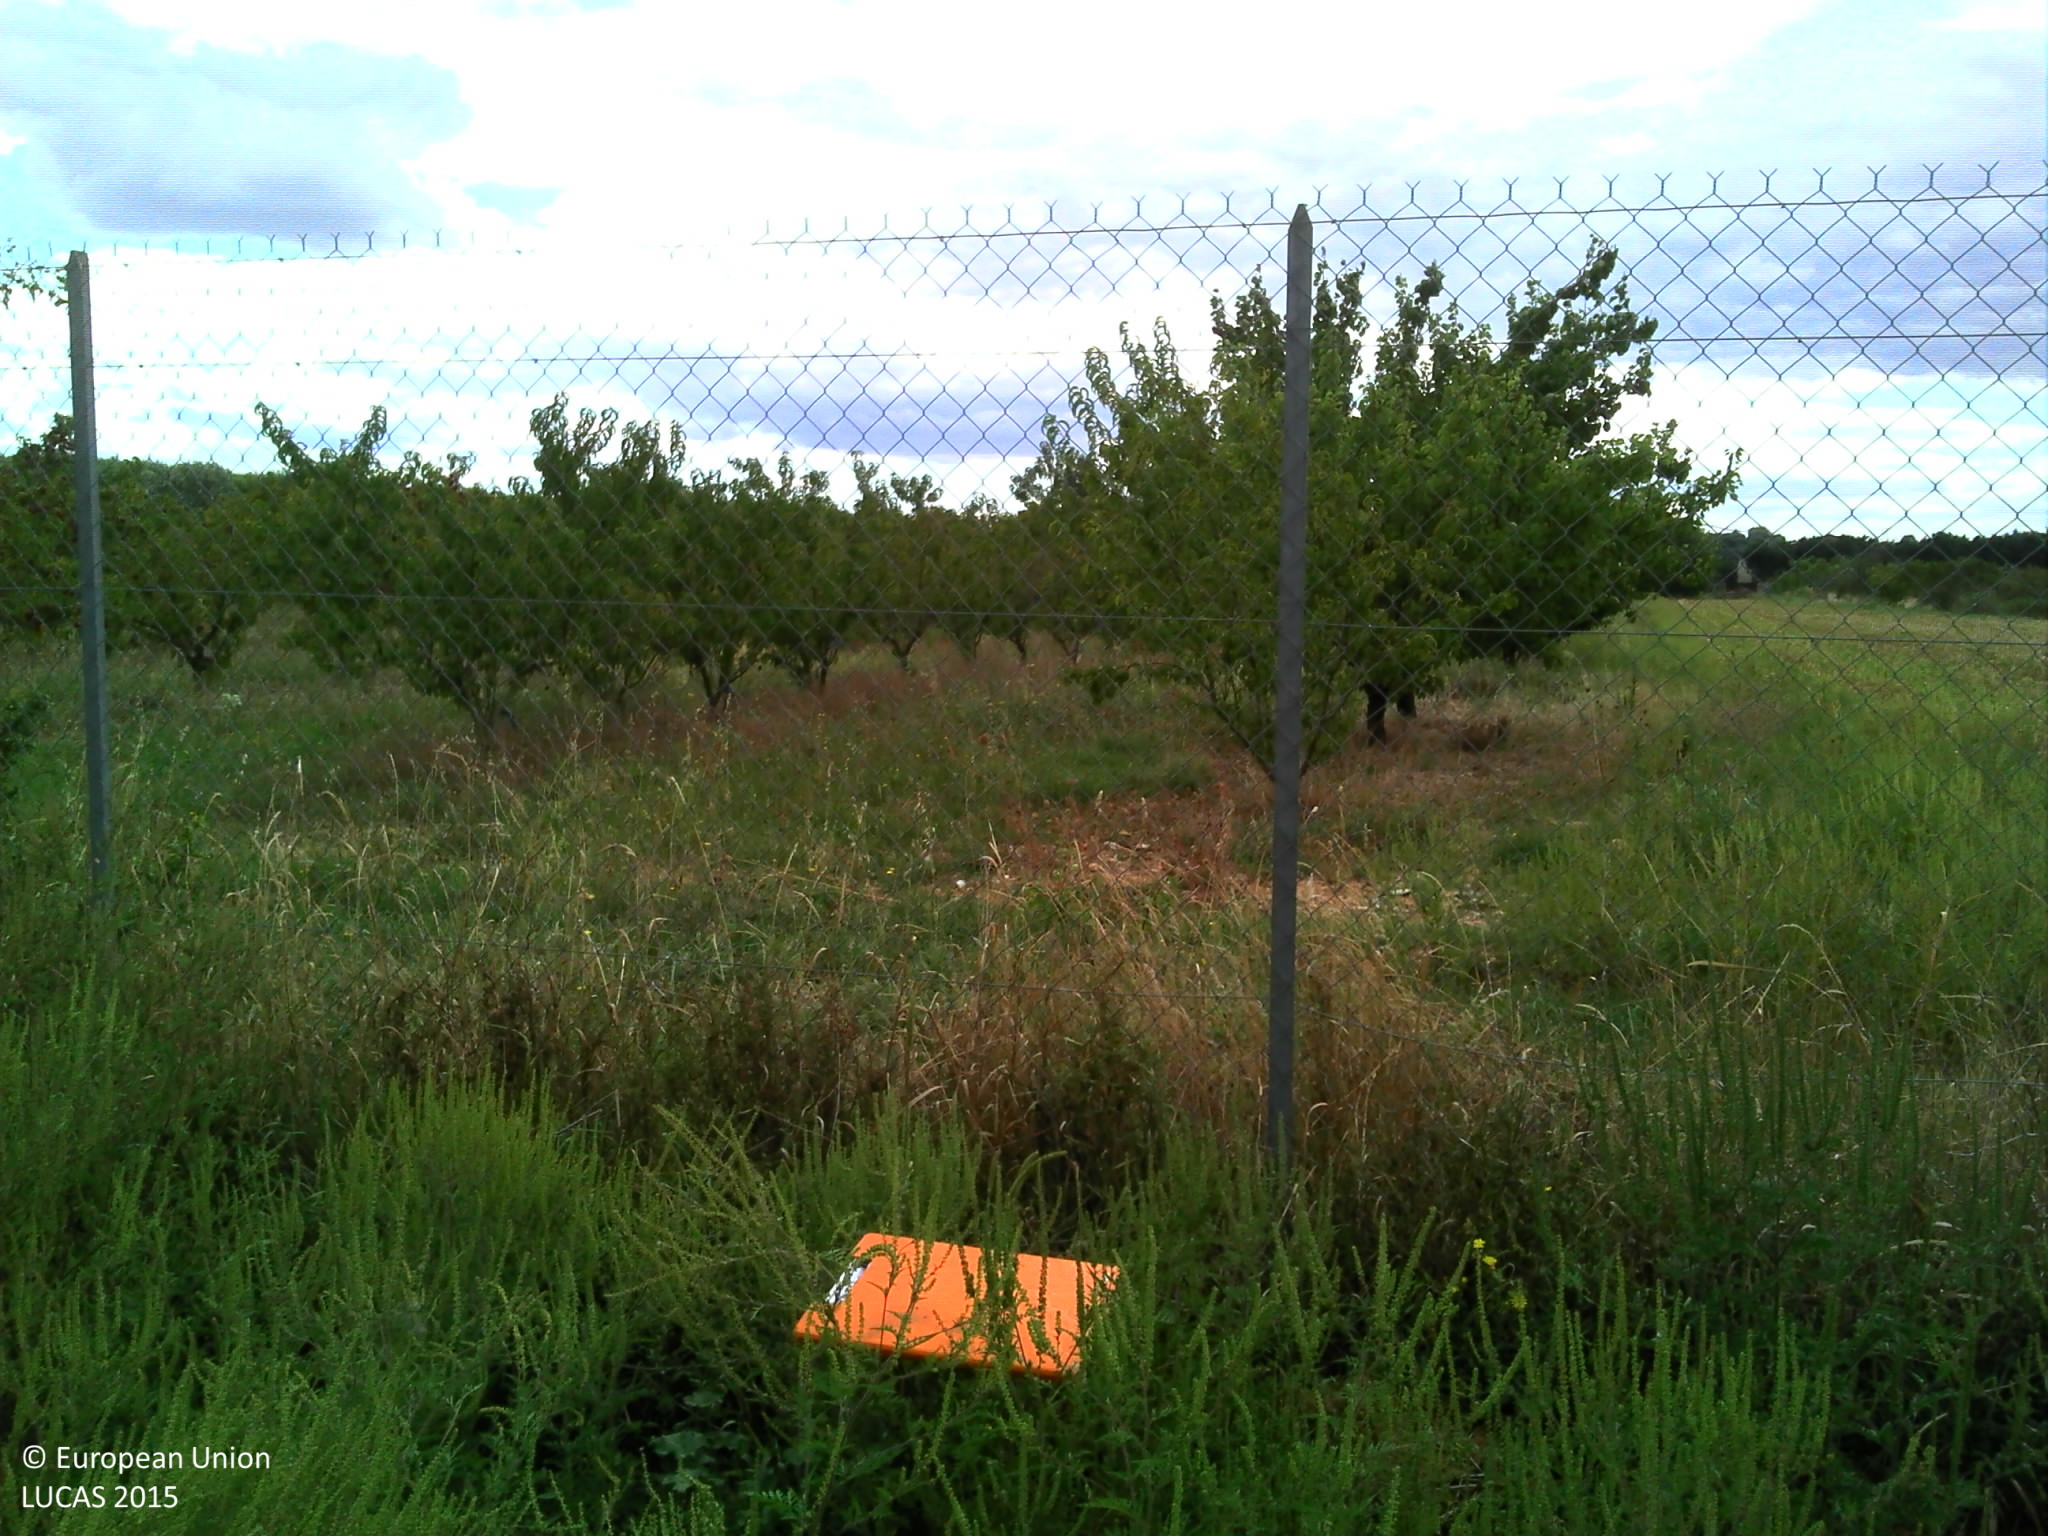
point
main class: Cropland
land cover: Maize
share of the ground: > 75 %
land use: Agriculture (excluding fallow land and kitchen gardens)
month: September
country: FR
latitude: 44.9130
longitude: 4.9265
